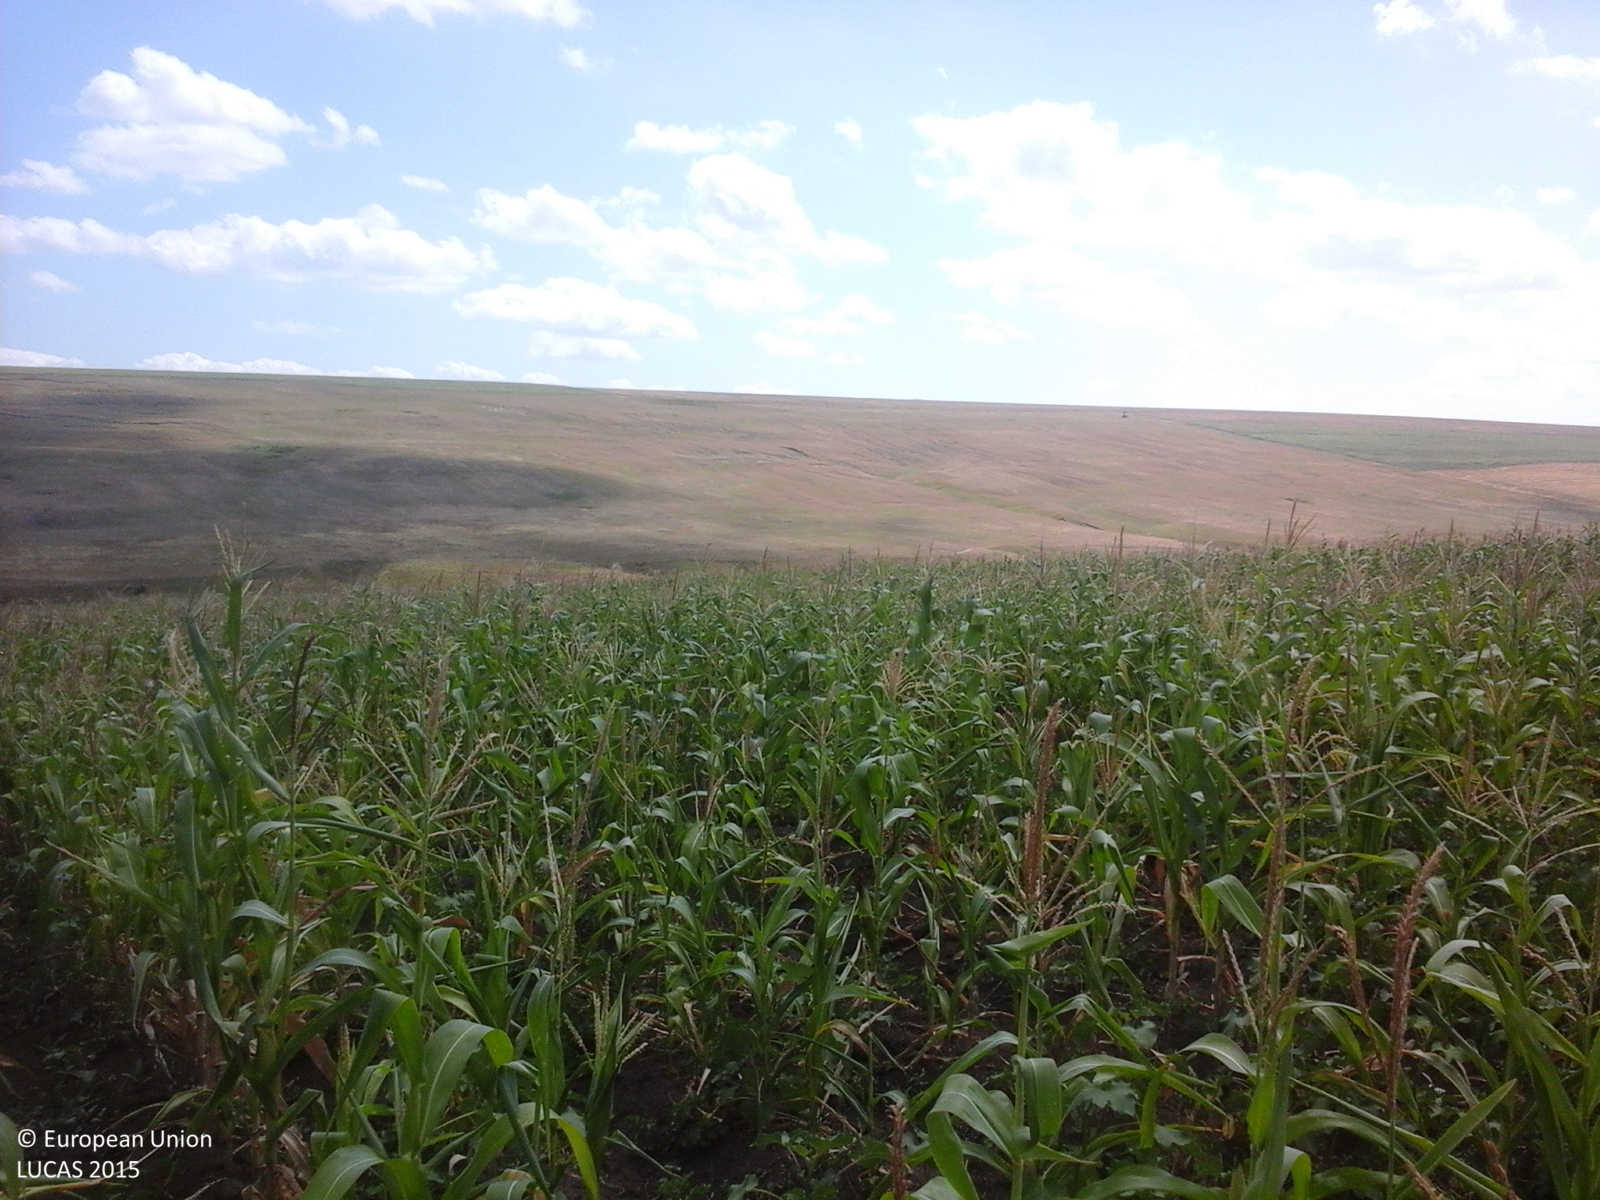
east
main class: Cropland
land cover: Maize
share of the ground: > 75 %
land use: Agriculture (excluding fallow land and kitchen gardens)
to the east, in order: Maize; Common wheat
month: July
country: RO
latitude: 46.3660
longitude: 27.9443
